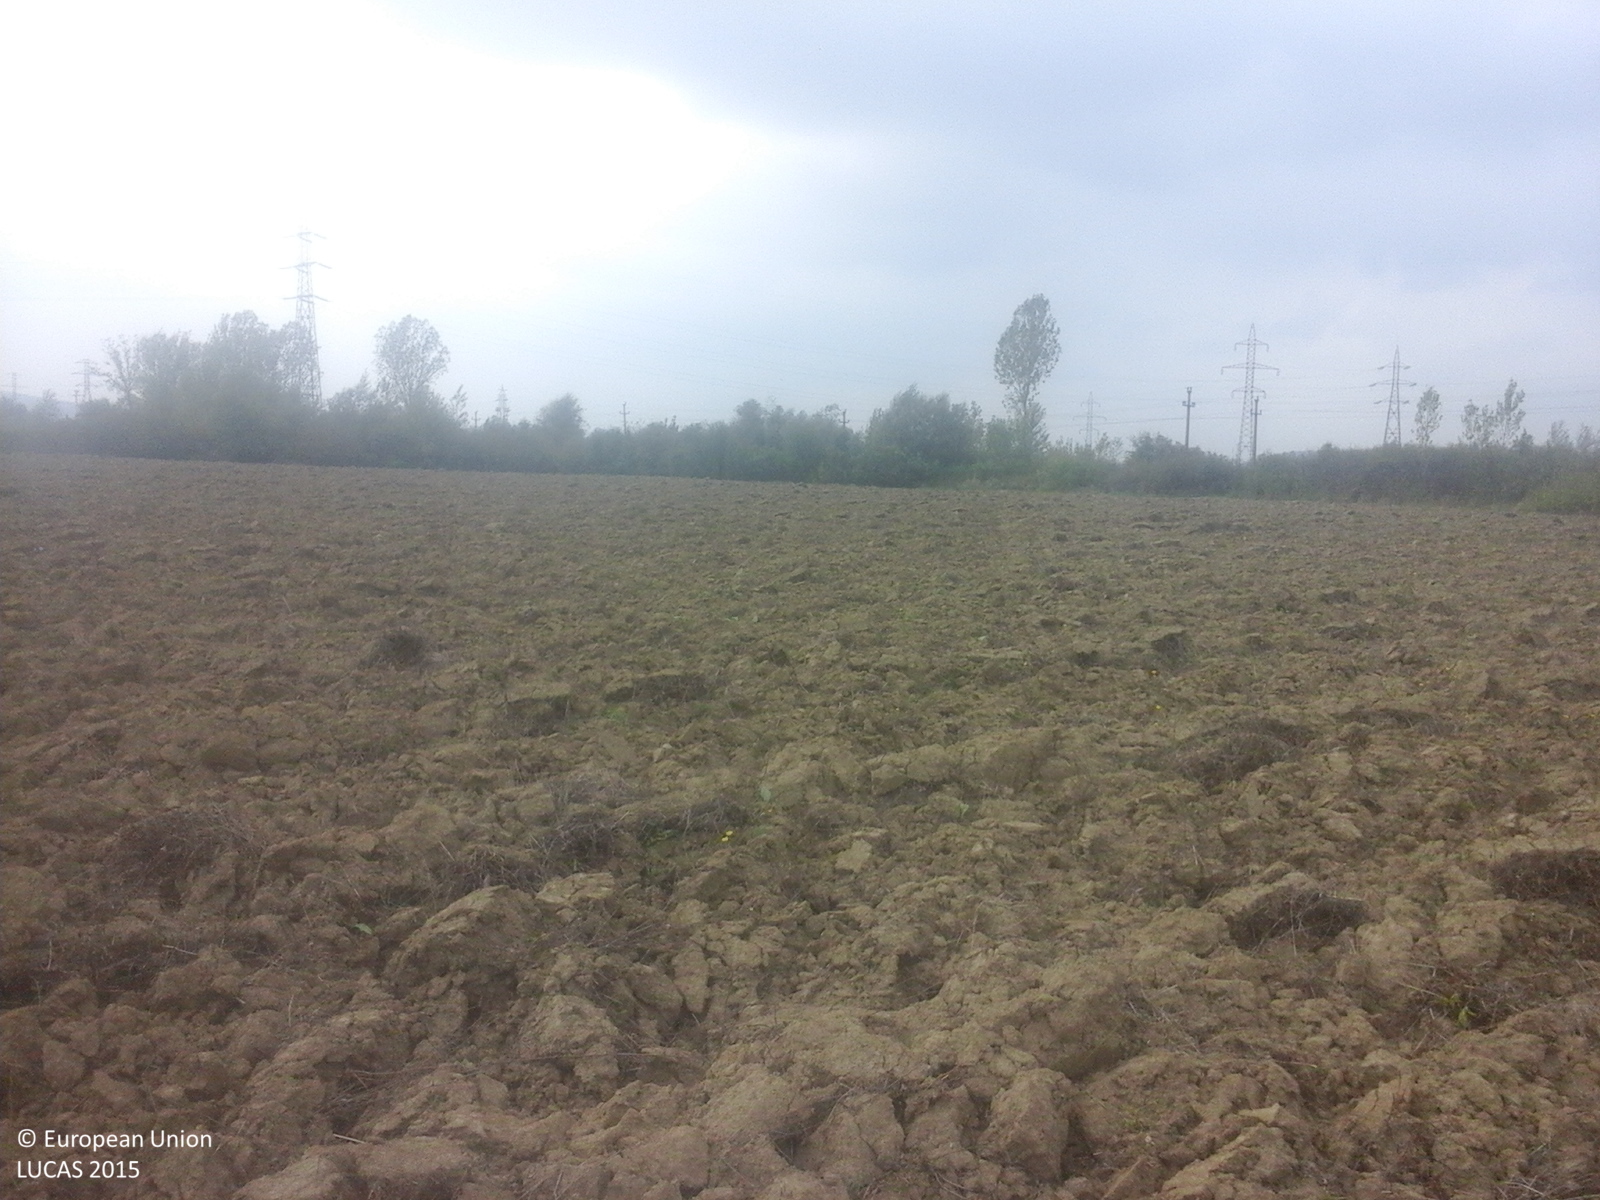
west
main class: Grassland
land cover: Grassland without tree/shrub cover
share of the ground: < 10 %
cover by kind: herbaceous plants 100 %
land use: Agriculture (excluding fallow land and kitchen gardens)
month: September
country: RO
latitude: 44.6804
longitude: 23.4136
